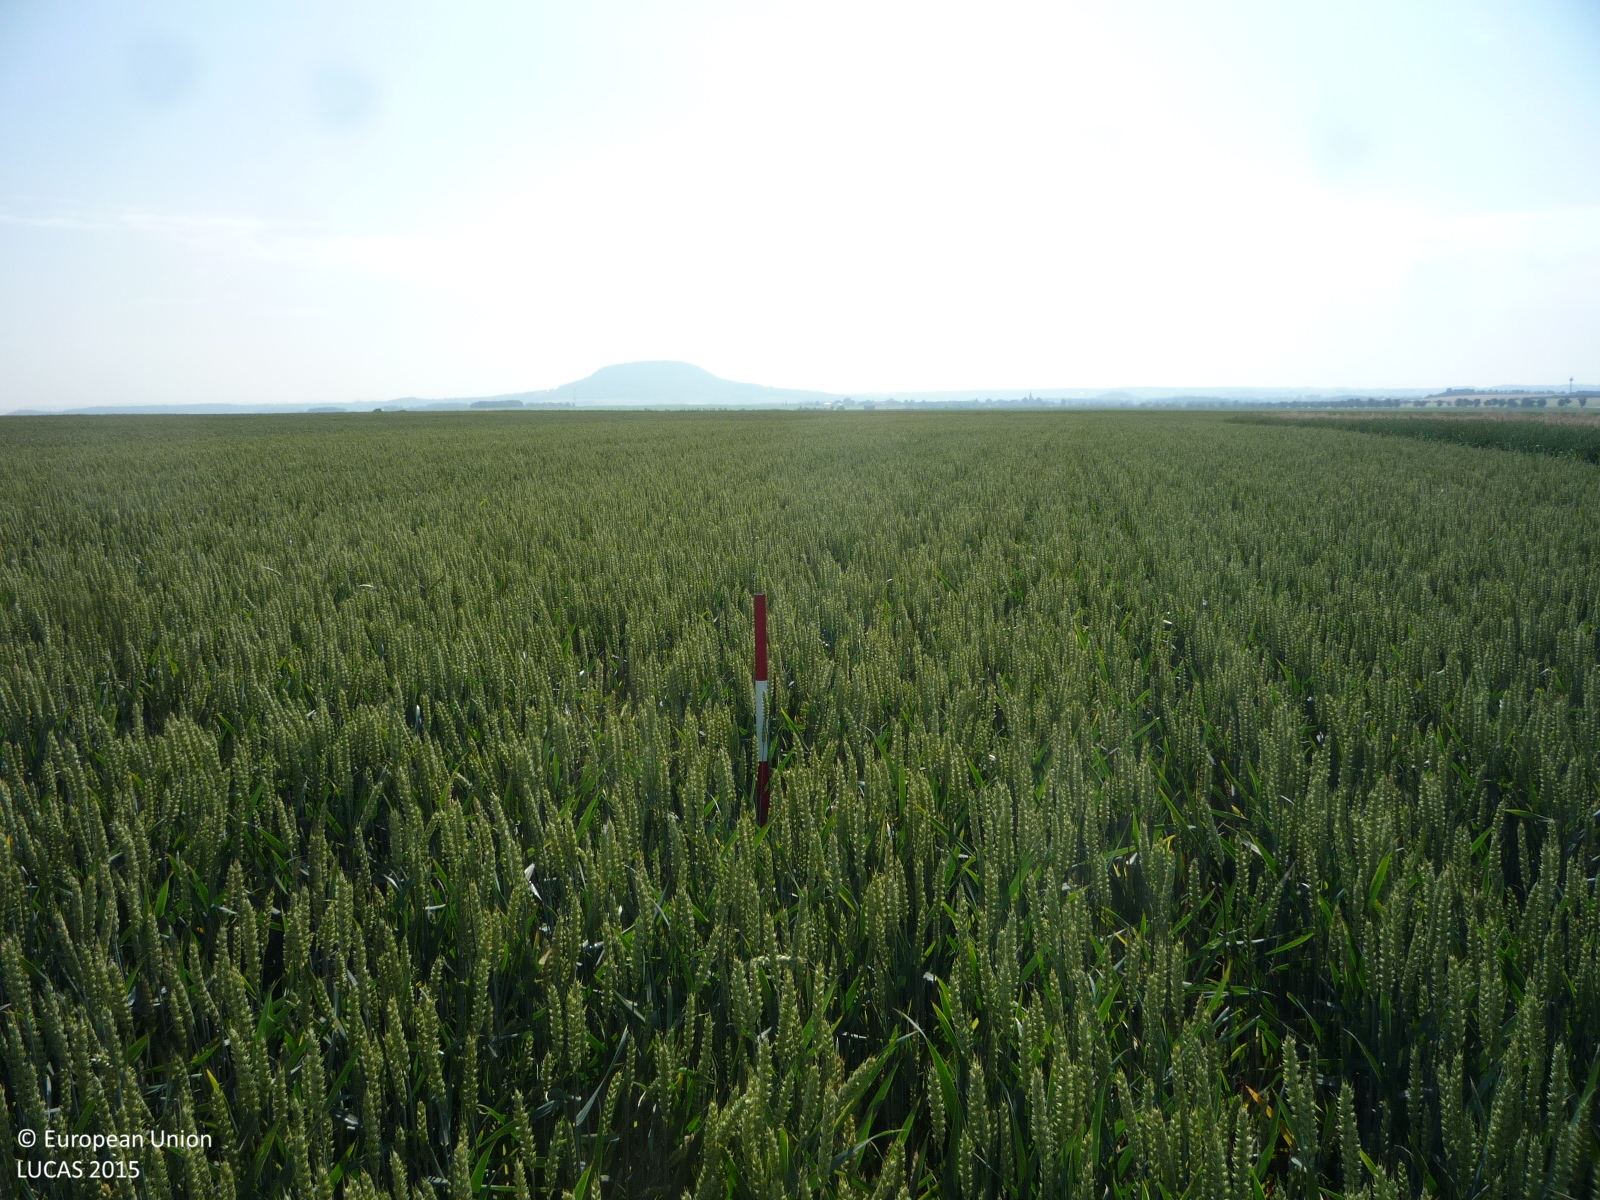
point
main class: Cropland
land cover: Common wheat
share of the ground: > 75 %
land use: Agriculture (excluding fallow land and kitchen gardens)
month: June
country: CZ
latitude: 50.3778
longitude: 14.1776
